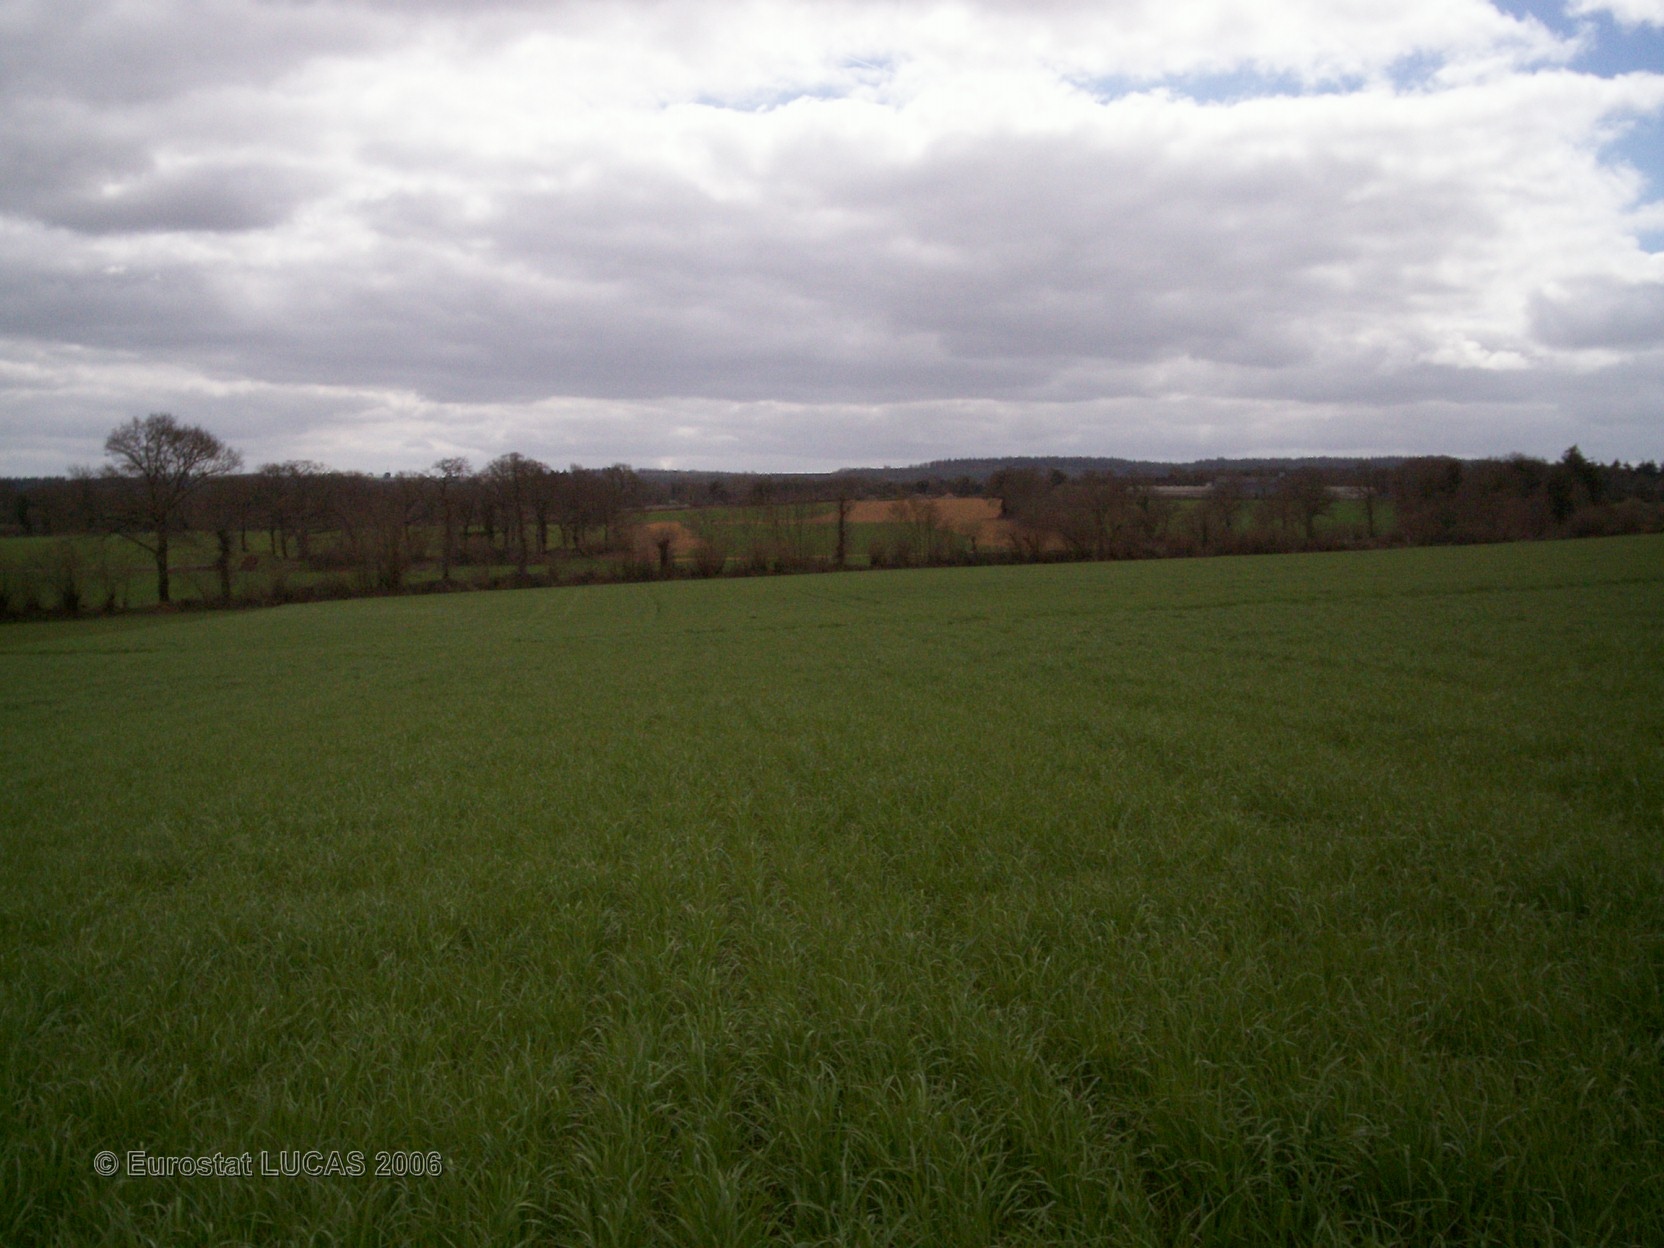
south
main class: Grassland
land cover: Grassland without tree/shrub cover
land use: Agriculture (excluding fallow land and kitchen gardens)
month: April
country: FR
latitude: 48.2145
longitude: -3.6053
